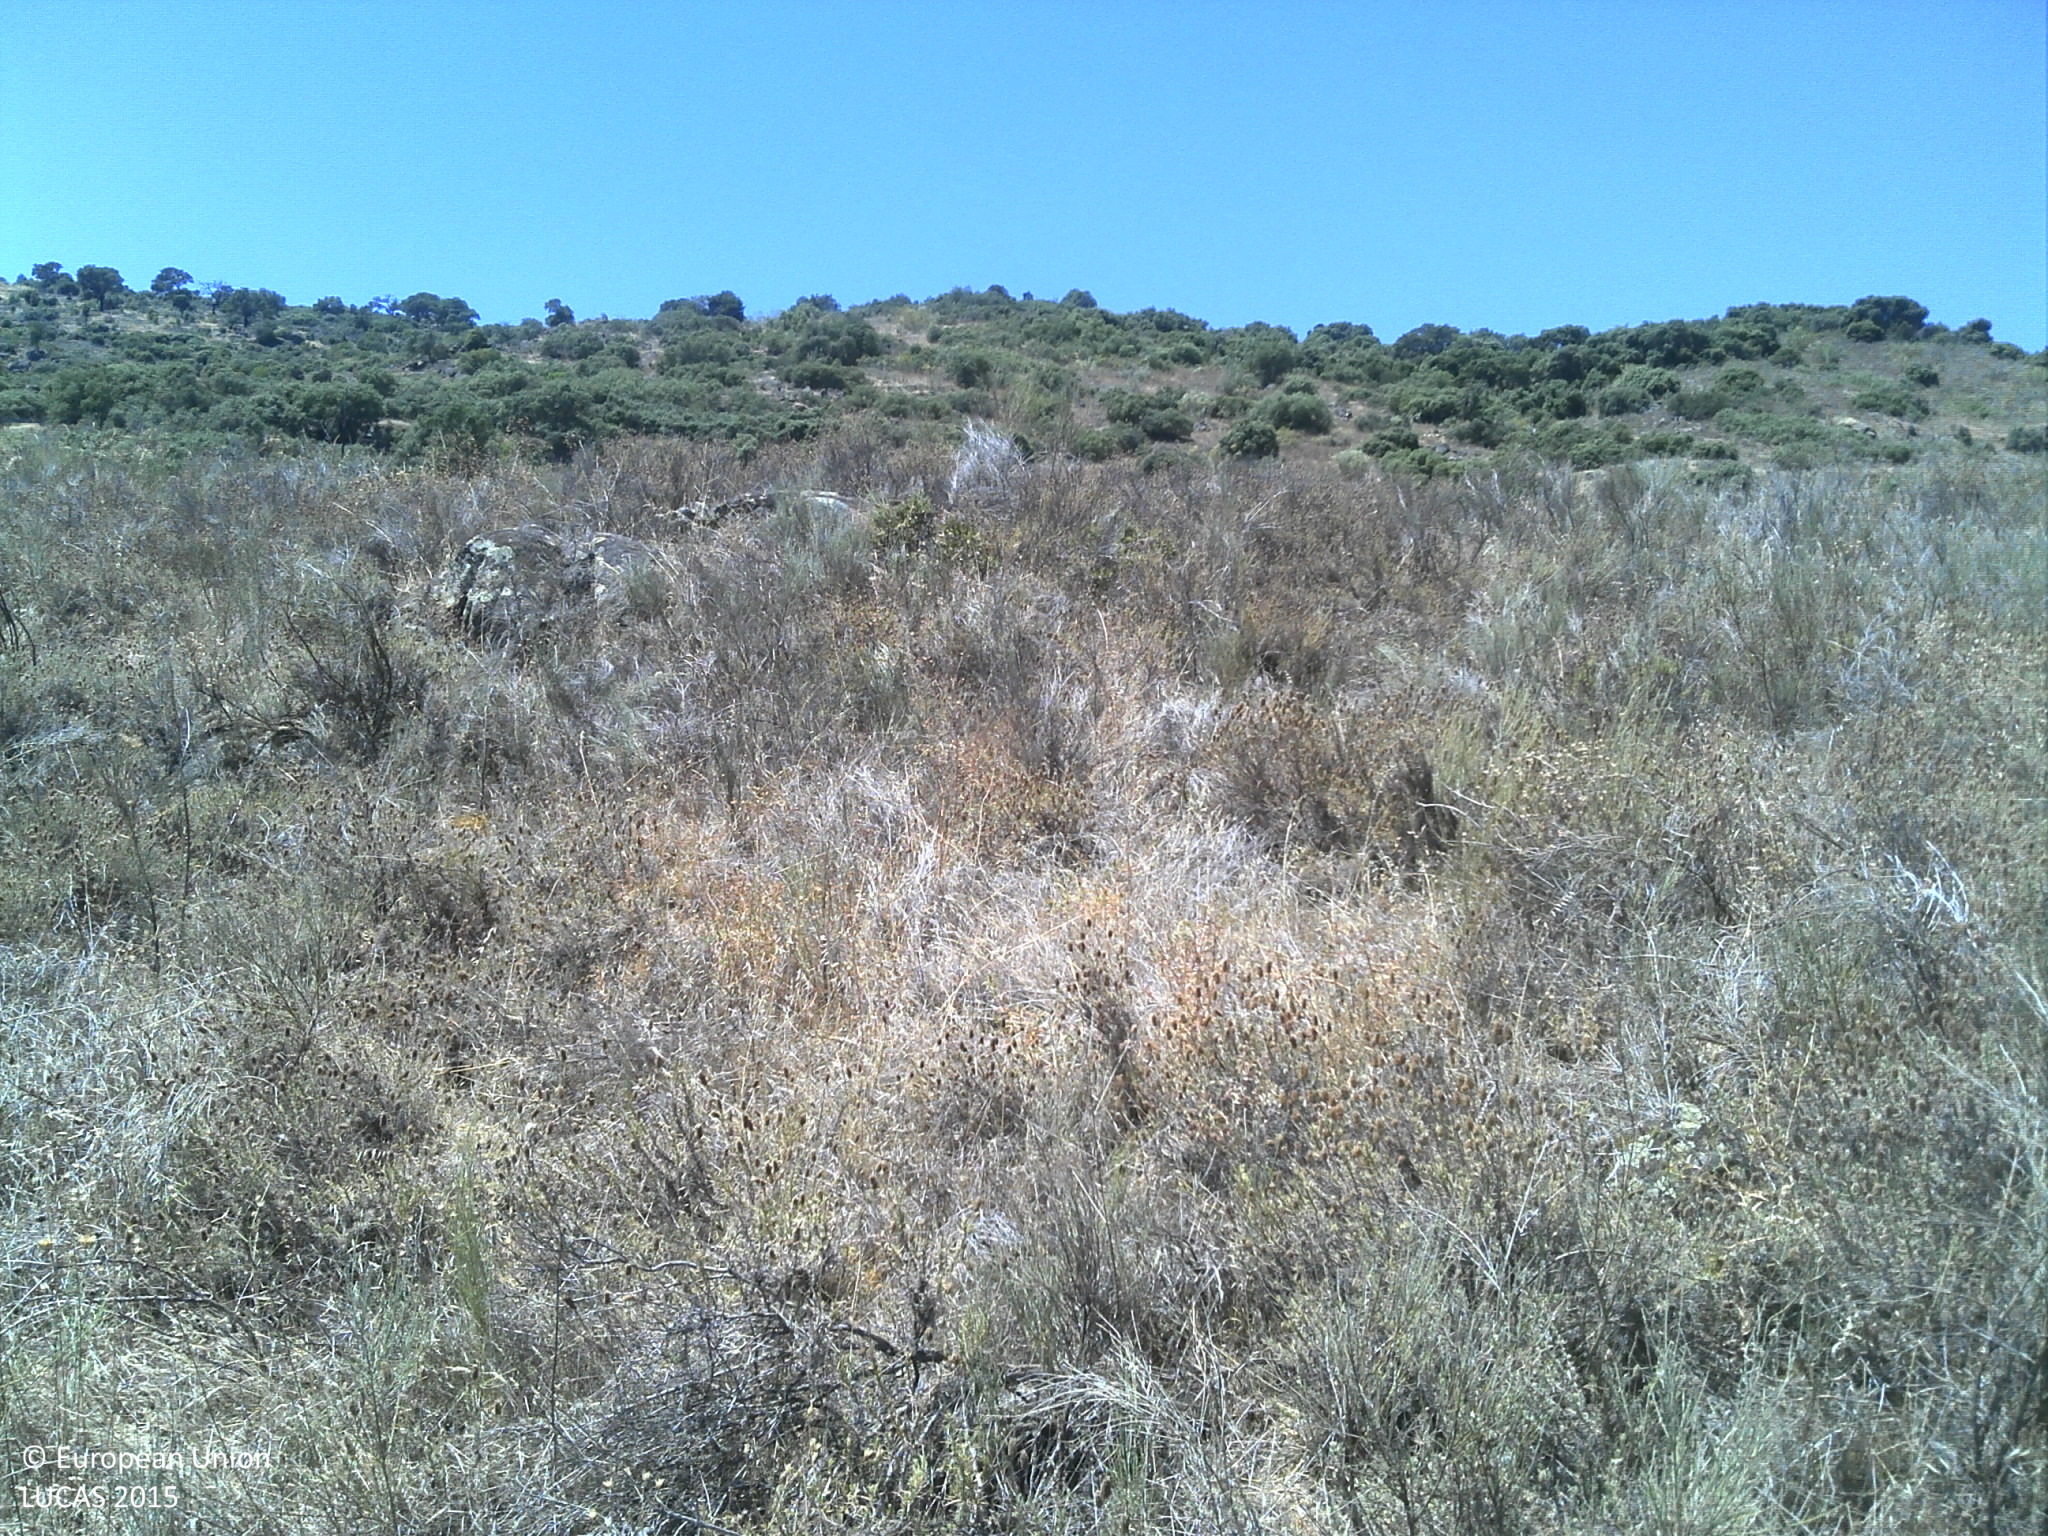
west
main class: Shrubland
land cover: Shrubland without tree cover
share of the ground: > 75 %
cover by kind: shrubs 100 %
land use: Semi-natural and natural areas not in use
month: July
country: PT
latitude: 41.3787
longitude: -7.0575
